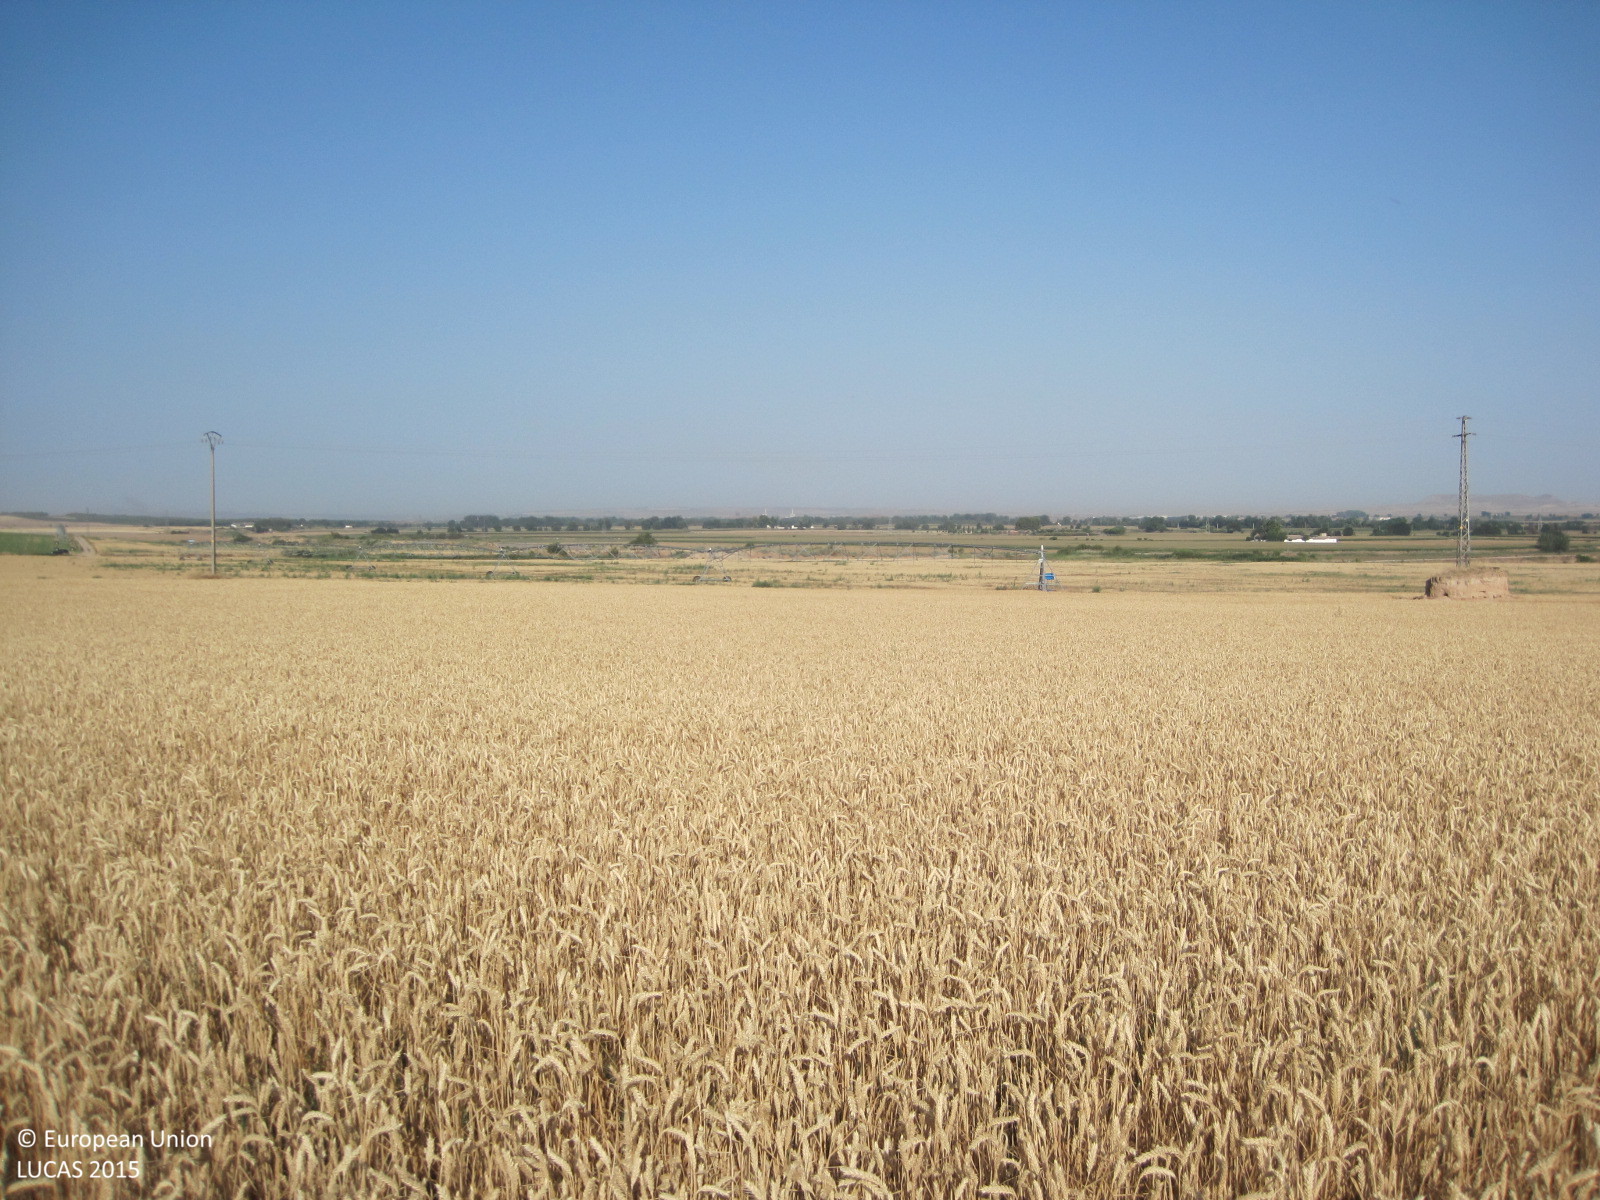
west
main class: Cropland
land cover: Common wheat
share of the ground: > 75 %
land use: Agriculture (excluding fallow land and kitchen gardens)
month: July
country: ES
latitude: 39.9553
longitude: -3.7392
